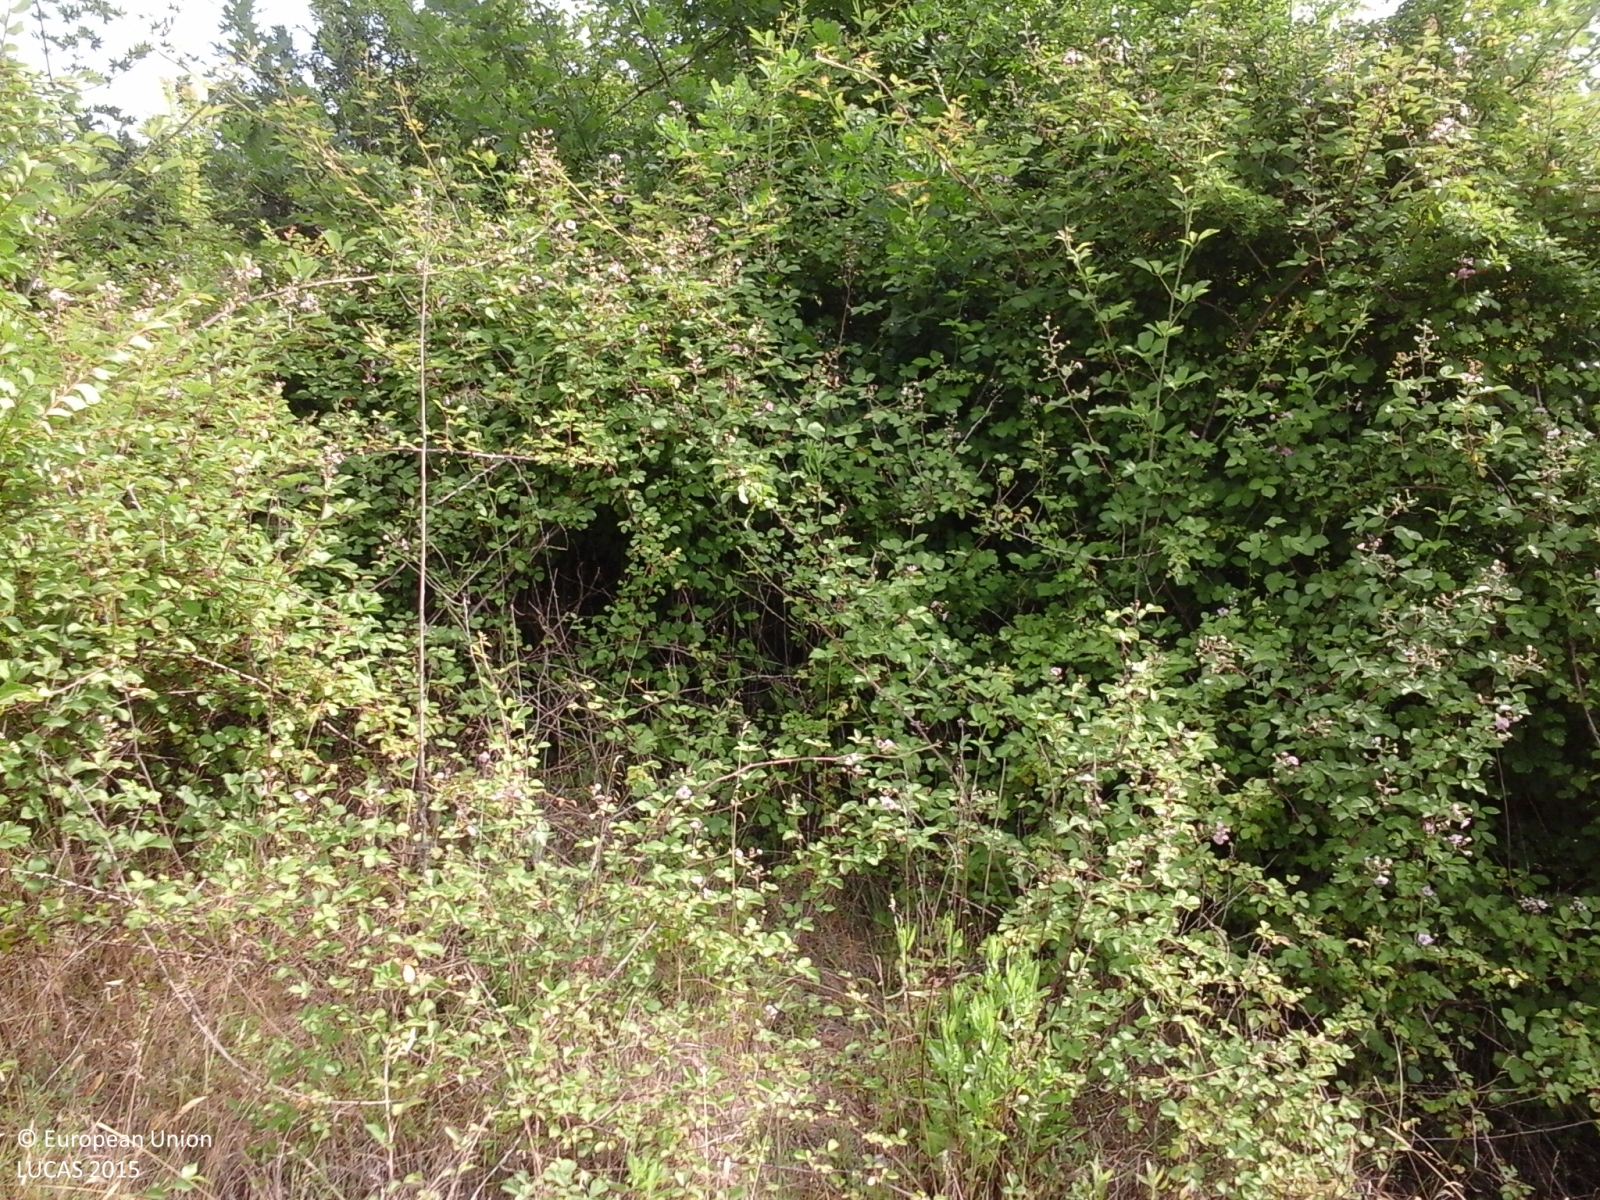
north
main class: Grassland
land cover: Grassland without tree/shrub cover
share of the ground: > 75 %
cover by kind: herbaceous plants 100 %
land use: Agriculture (excluding fallow land and kitchen gardens)
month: June
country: IT
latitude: 41.5841
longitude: 13.4056
